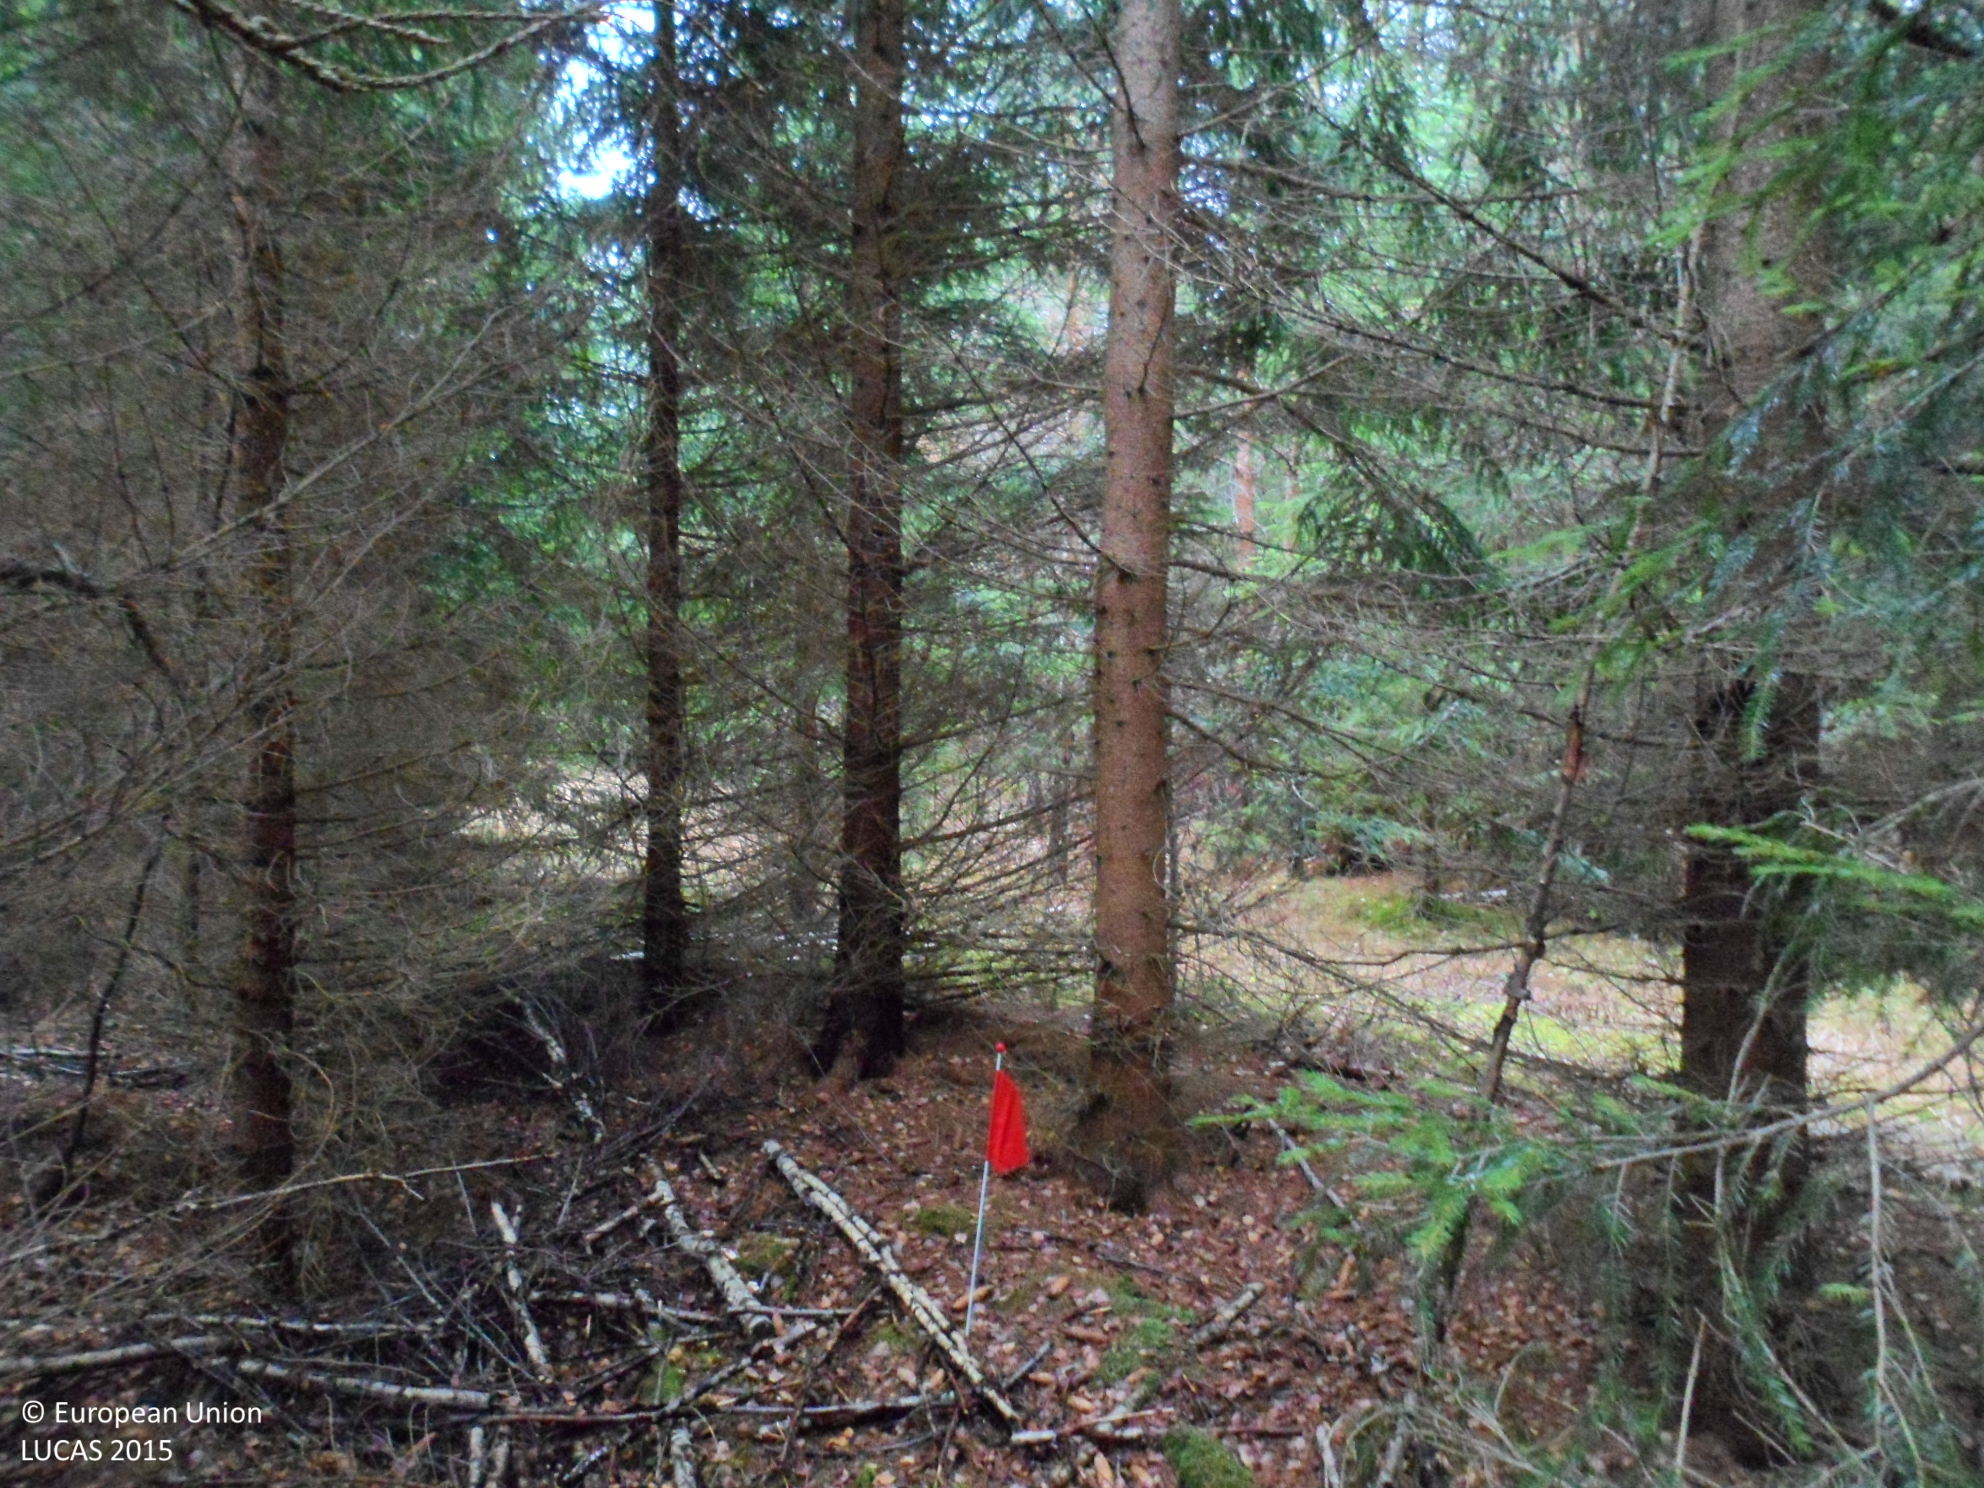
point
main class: Woodland
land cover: Spruce dominated coniferous woodland
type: boreal forest
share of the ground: > 75 %
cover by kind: coniferous forest trees 75 %, unconsolidated bare surface 15 %, broadleaved forest trees 5 %, lichens and mosses 5 %
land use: Forestry
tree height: > 5 m
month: November
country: SE
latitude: 56.7925
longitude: 15.8766
